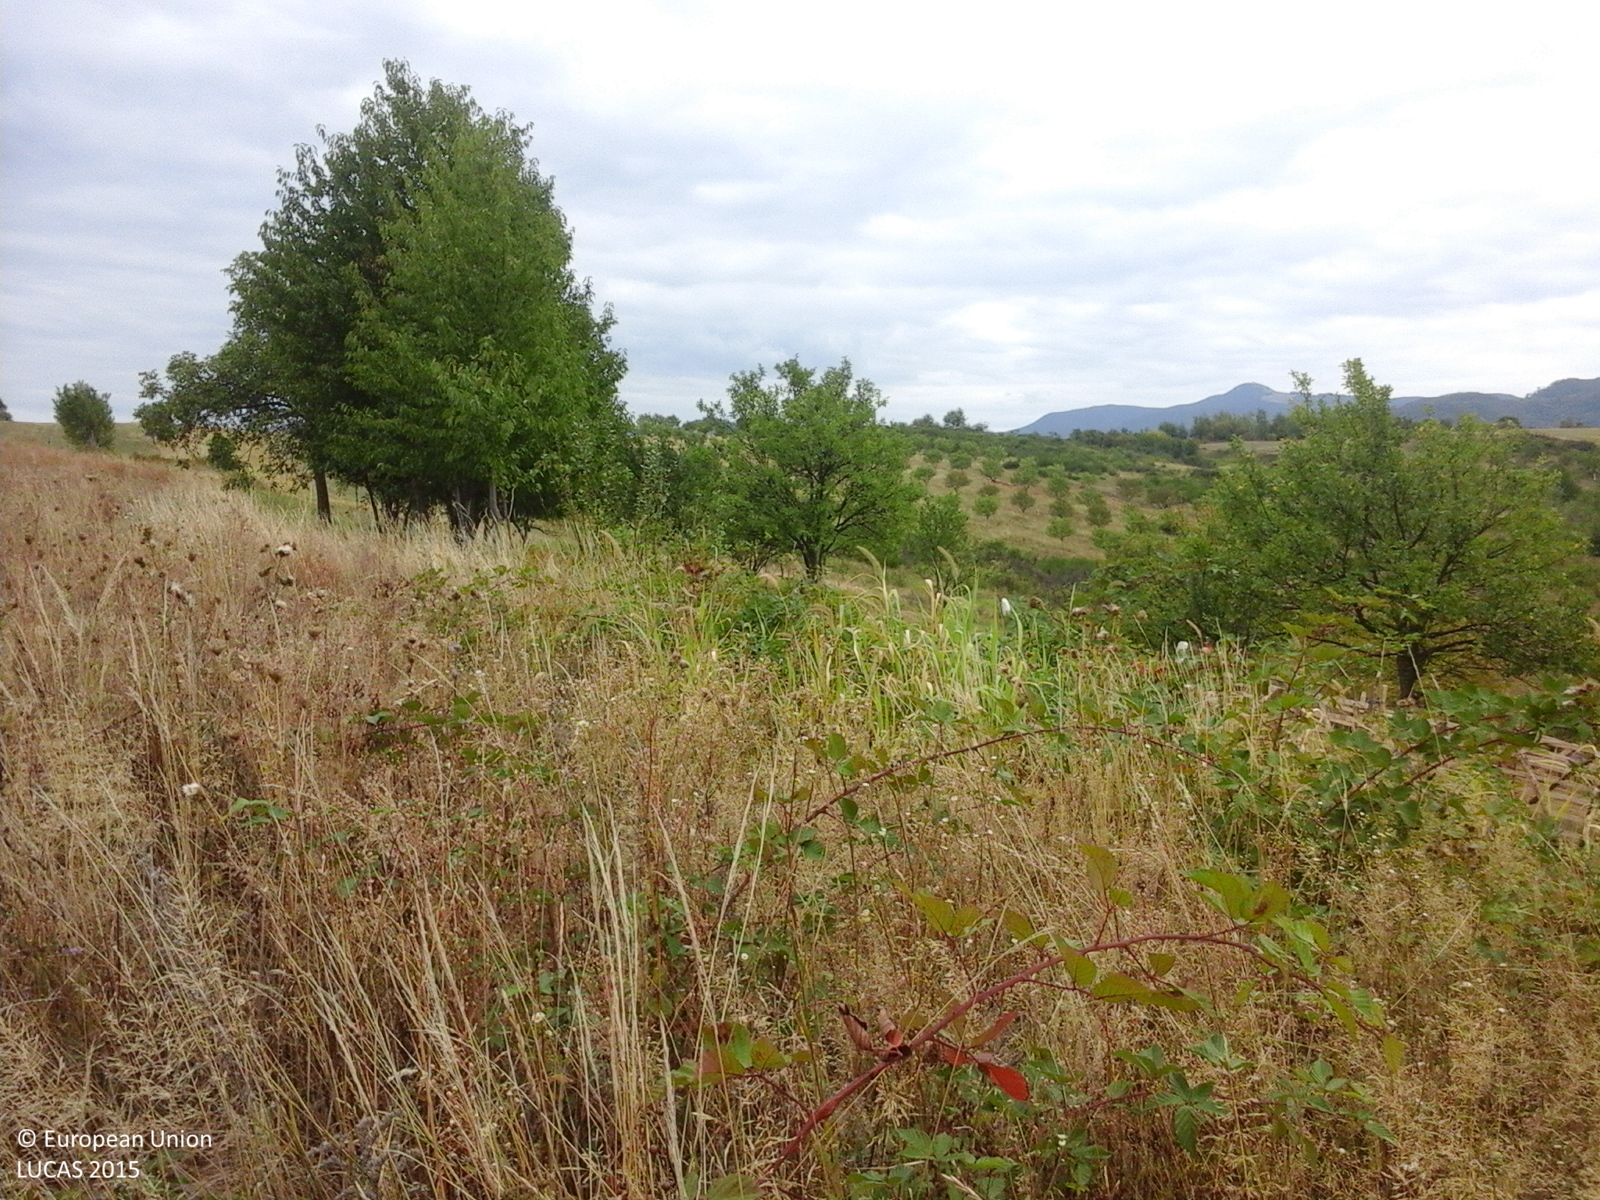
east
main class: Grassland
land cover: Spontaneously vegetated surfaces
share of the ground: > 75 %
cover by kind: herbaceous plants 100 %
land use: Fallow land
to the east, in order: Spontaneously vegetated surfaces; Other fruit trees and berries; Grassland without tree/shrub cover; Tracks; Shrubland with sparse tree cover; Other fruit trees and berries
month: September
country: RO
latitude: 47.8216
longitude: 23.3903
